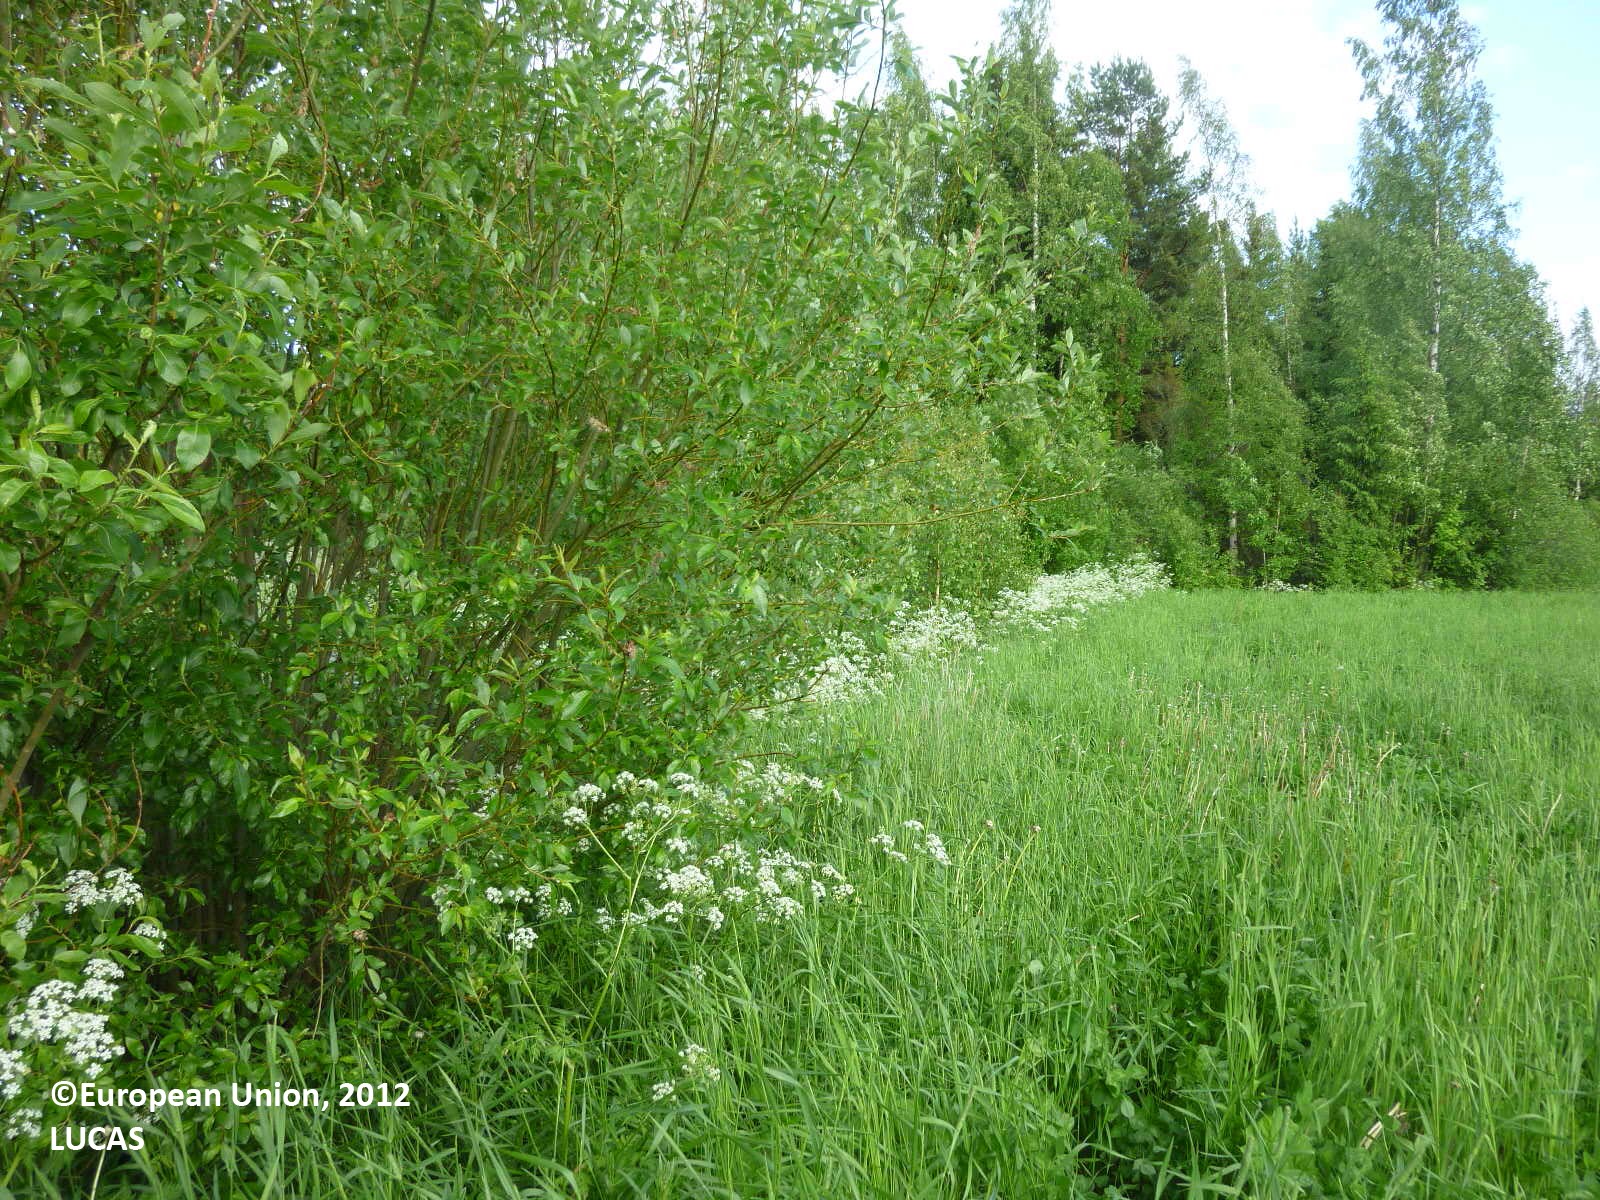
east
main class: Cropland
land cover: Temporary grasslands
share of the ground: 50 - 75 %
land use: Agriculture (excluding fallow land and kitchen gardens)
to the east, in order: Temporary grasslands; Grassland with sparse tree/shrub cover; Ditches and canals; Single bushes/trees; Grassland without tree/shrub cover; Broadleaved woodland; Ditches and canals; Broadleaved woodland; Electric lines; Grassland without tree/shrub cover; Other bare soil; Grassland without tree/shrub cover; Ditches and canals; Grass margins; Paved roads, cycling and walking lanes; Grass margins; Ditches and canals; Grassland without tree/shrub cover
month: June
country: FI
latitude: 61.5968
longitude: 22.4815
